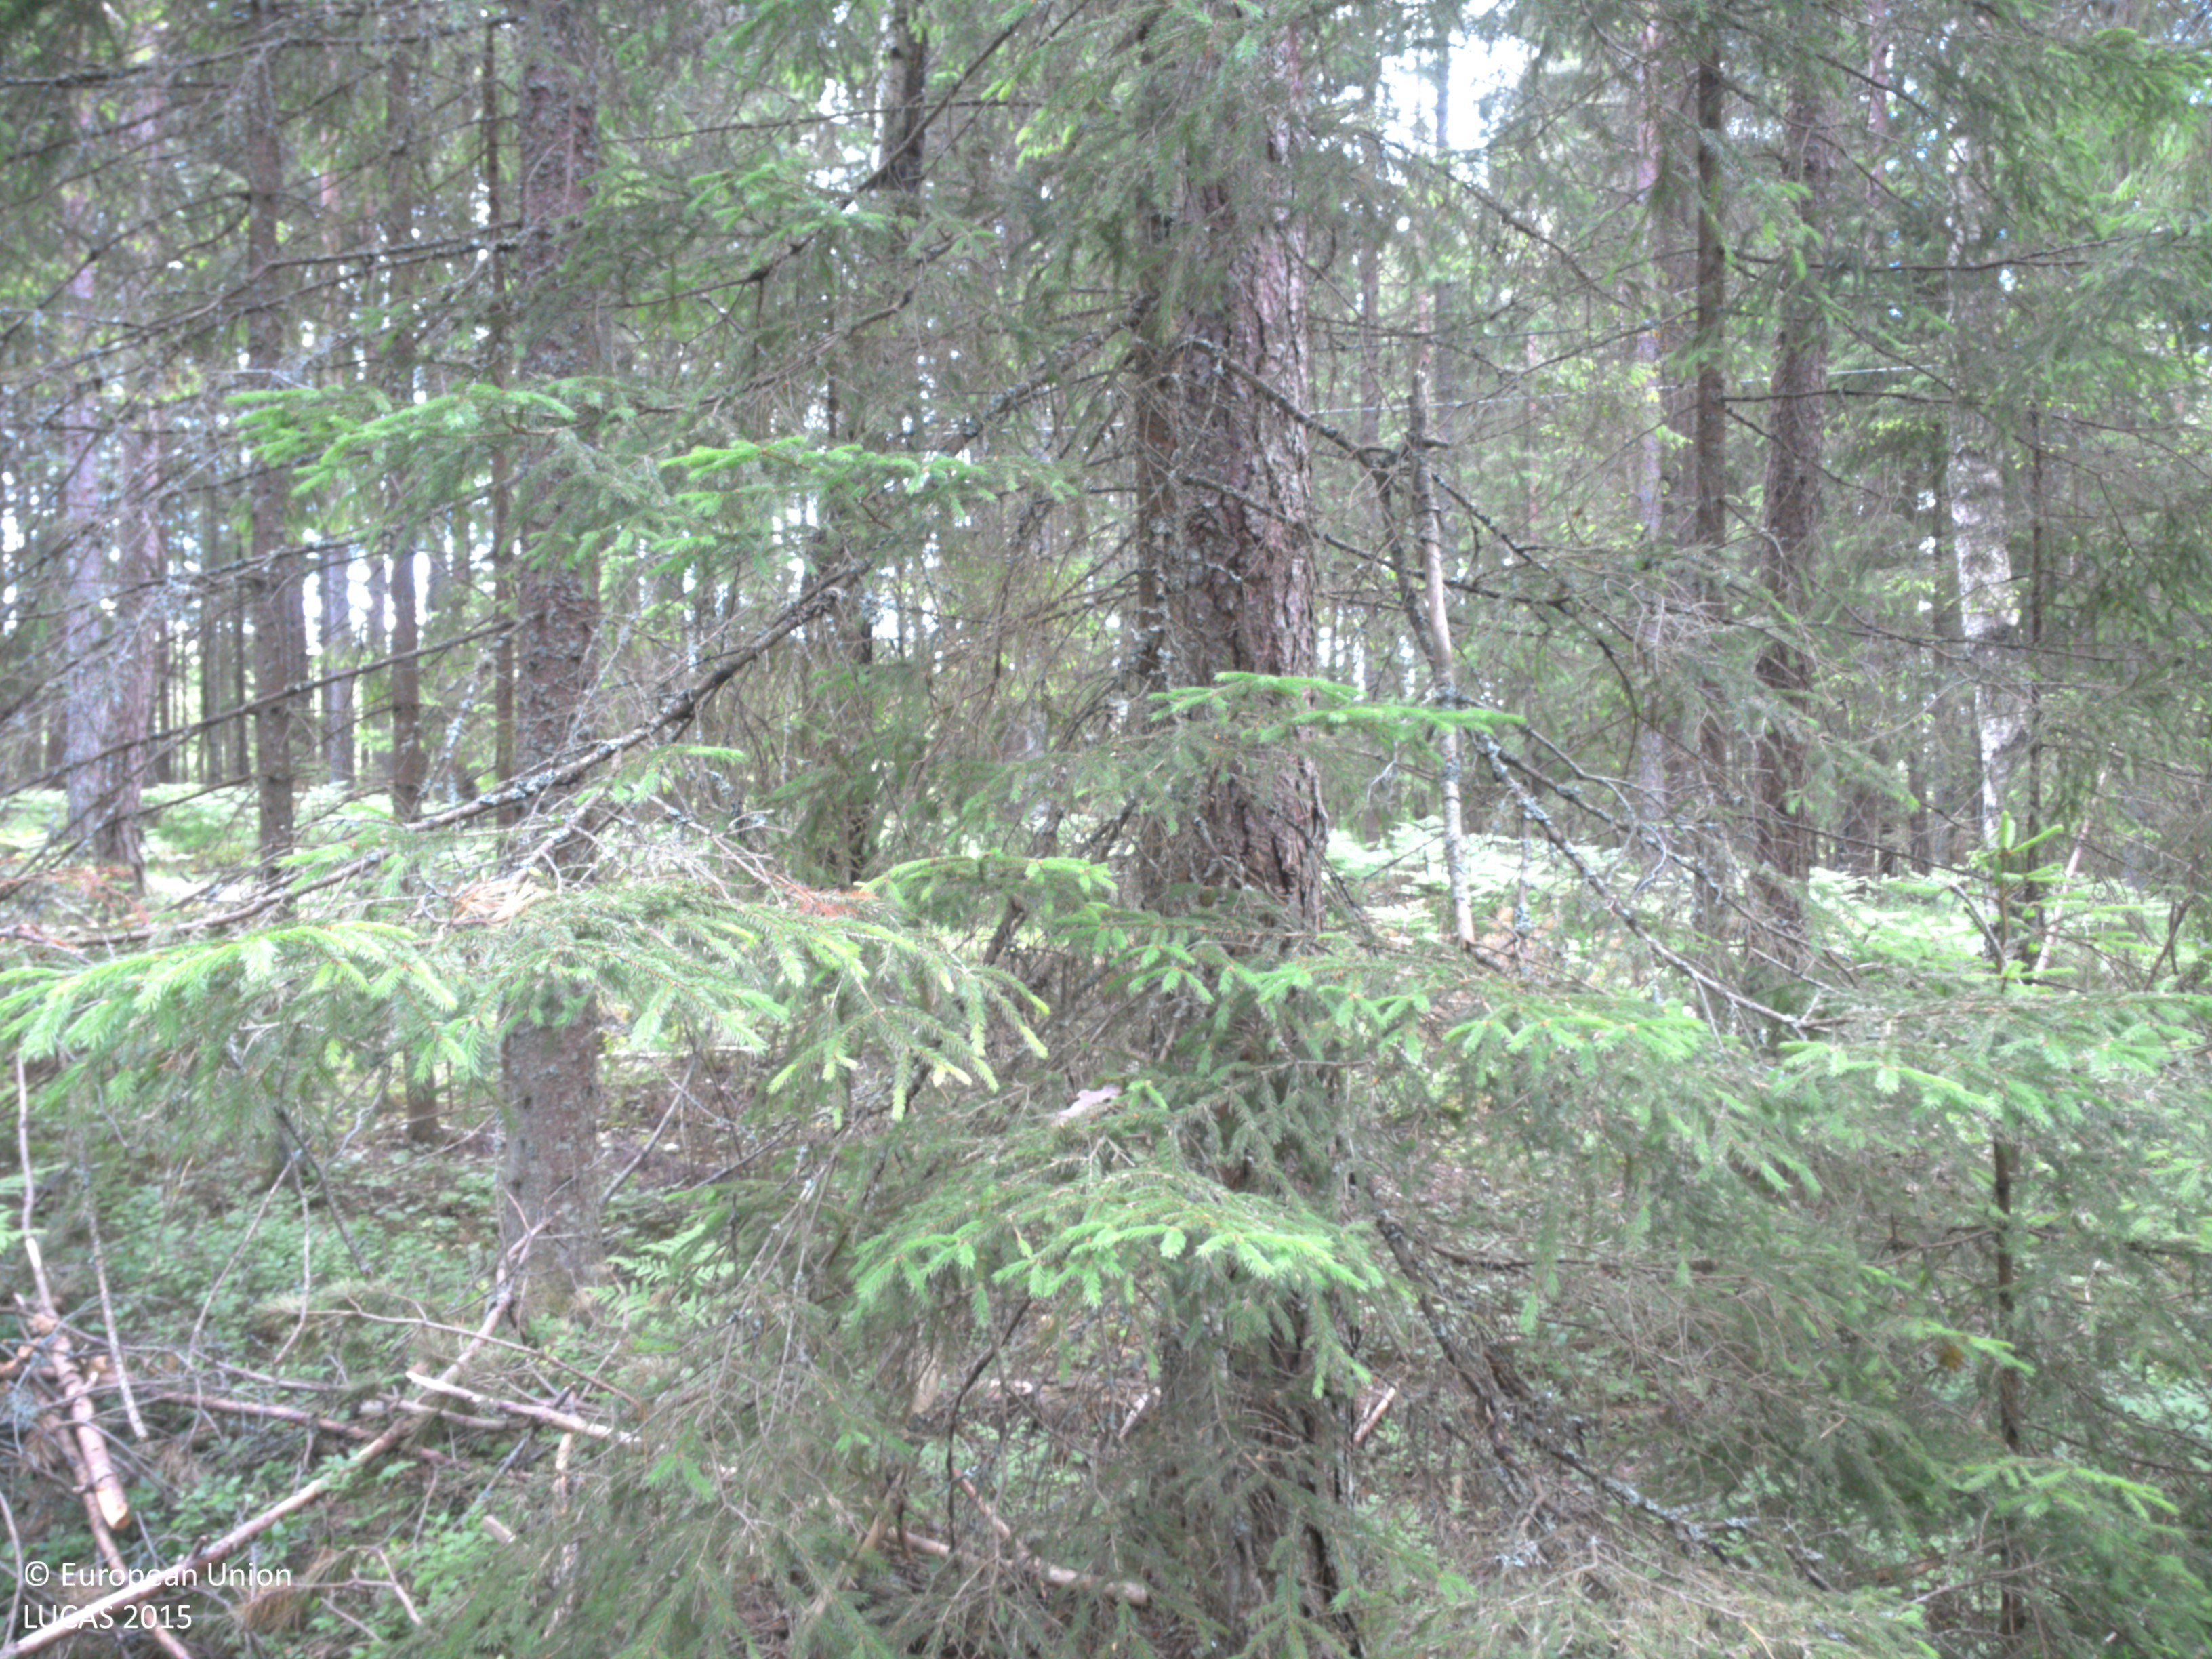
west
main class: Woodland
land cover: Other coniferous woodland
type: boreal forest
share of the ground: 50 - 75 %
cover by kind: coniferous forest trees 50 %, shrubs 25 %, lichens and mosses 15 %, herbaceous plants 10 %
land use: Forestry
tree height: > 5 m
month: June
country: SE
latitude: 58.9370
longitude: 12.3404
